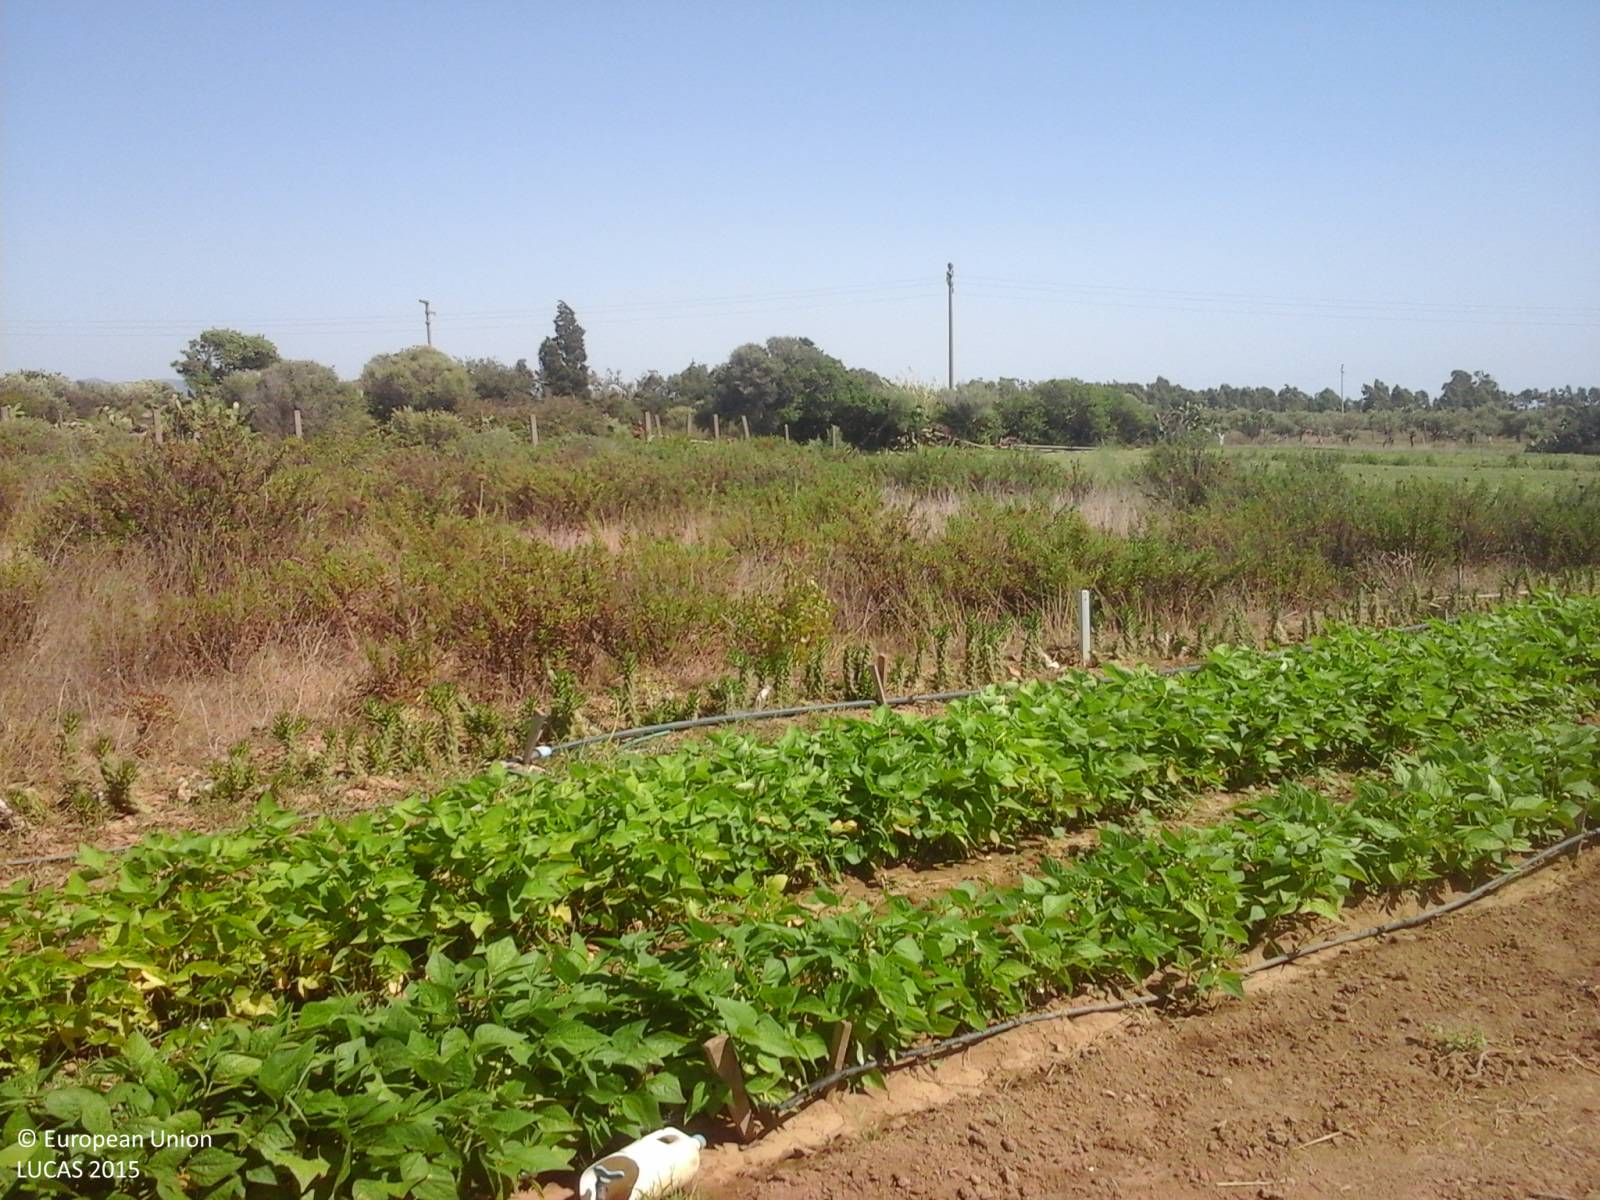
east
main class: Cropland
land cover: Other fresh vegetables
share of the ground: > 75 %
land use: Agriculture (excluding fallow land and kitchen gardens)
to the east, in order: Other fresh vegetables; Shrubland without tree cover; Abandoned hedges; Shrubland without tree cover; Permanent crops (only in case pi); Abandoned hedges; Fences; Grassland without tree/shrub cover; Vineyards; Fences; Tracks; Managed hedges; Spontaneously vegetated surfaces; Olive groves; Ditches and canals; Tracks; Grassland without tree/shrub cover; Fences; Managed hedges; Grassland without tree/shrub cover
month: July
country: IT
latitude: 39.0964
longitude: 8.4948
